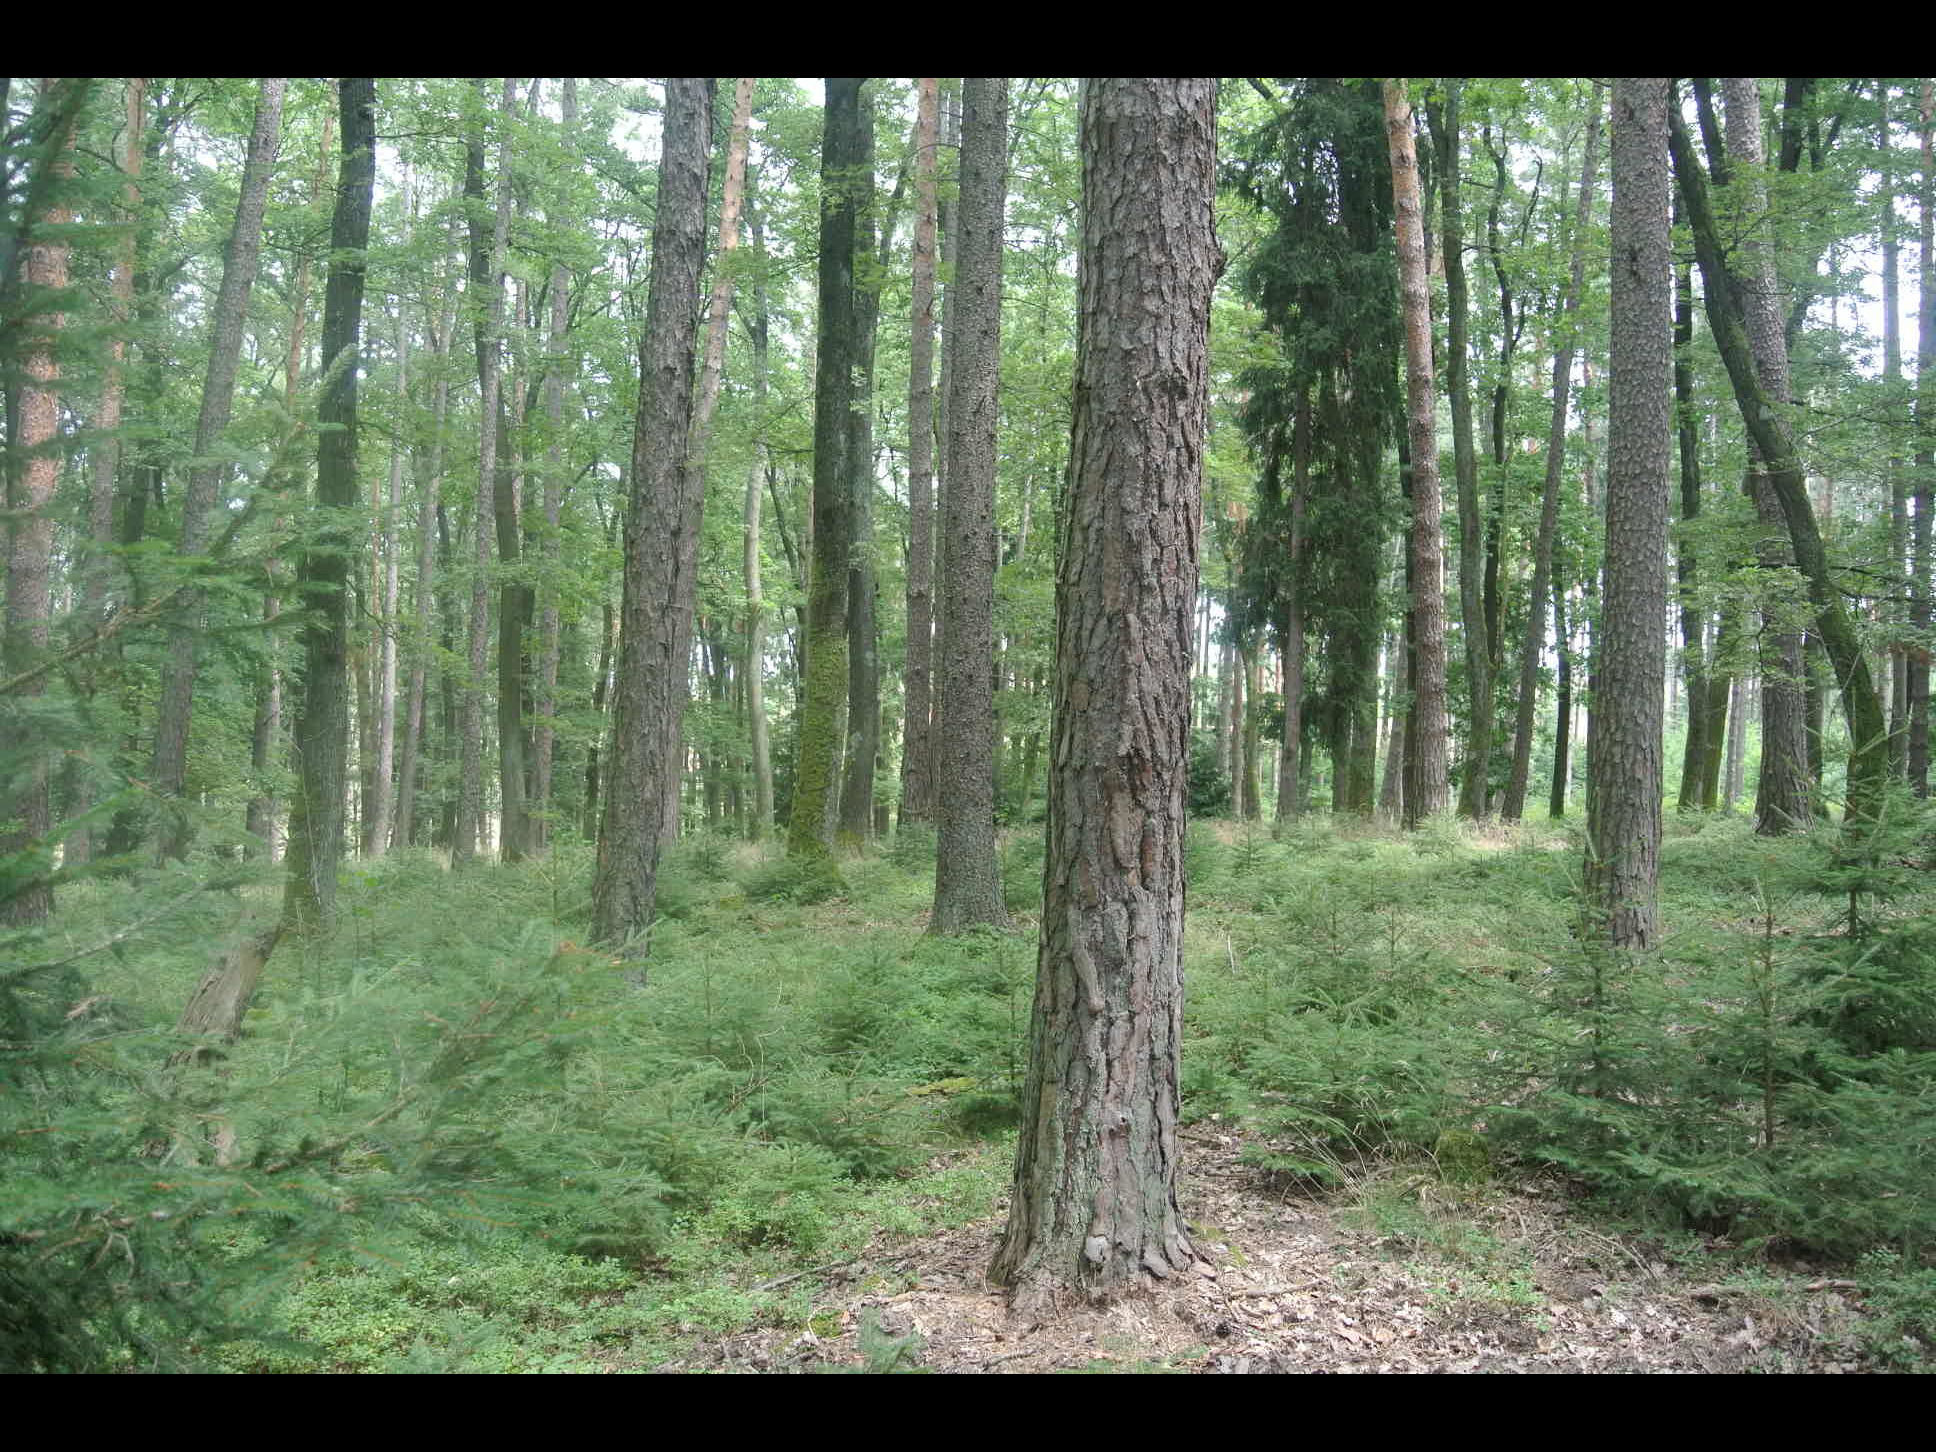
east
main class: Woodland
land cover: Pine dominated mixed woodland
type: alpine coniferous forest
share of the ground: > 75 %
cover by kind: coniferous forest trees 55 %, broadleaved forest trees 45 %
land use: Forestry
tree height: > 5 m
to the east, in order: Pine dominated mixed woodland; Pine dominated coniferous woodland; Grassland with sparse tree/shrub cover
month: July
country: AT
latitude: 47.4756
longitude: 16.4390
